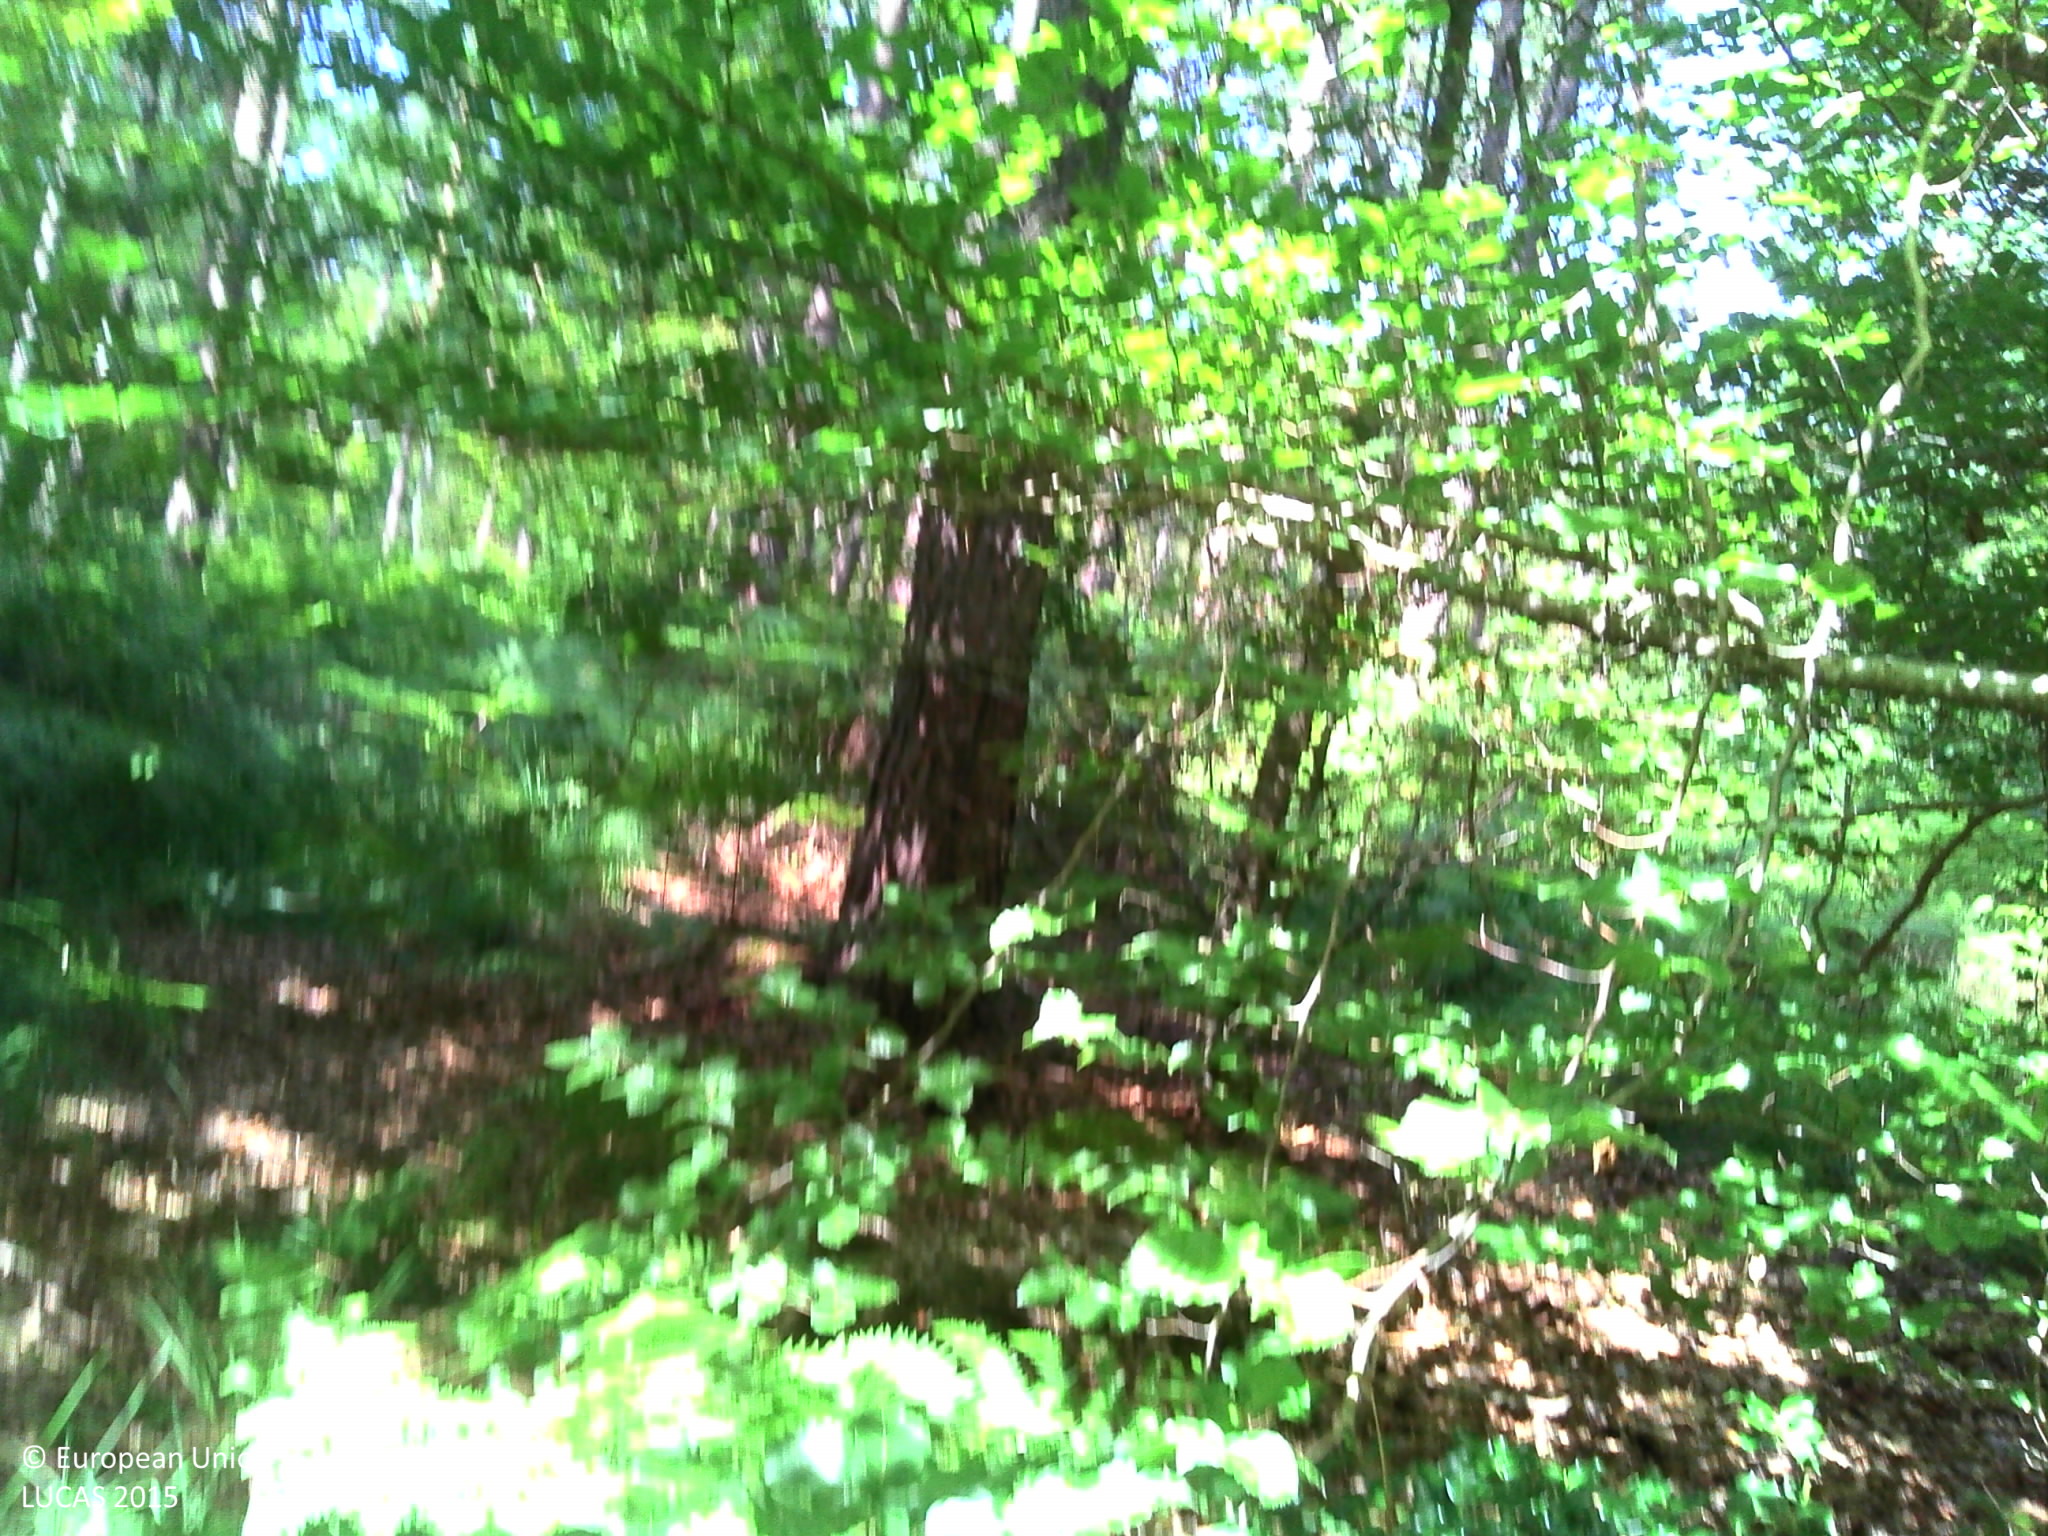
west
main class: Woodland
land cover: Pine dominated mixed woodland
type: mesophytic deciduous forest
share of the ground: > 75 %
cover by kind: broadleaved forest trees 50 %, coniferous forest trees 40 %, herbaceous plants 10 %
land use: Forestry
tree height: > 5 m
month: August
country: FR
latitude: 47.2688
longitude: 2.0732
